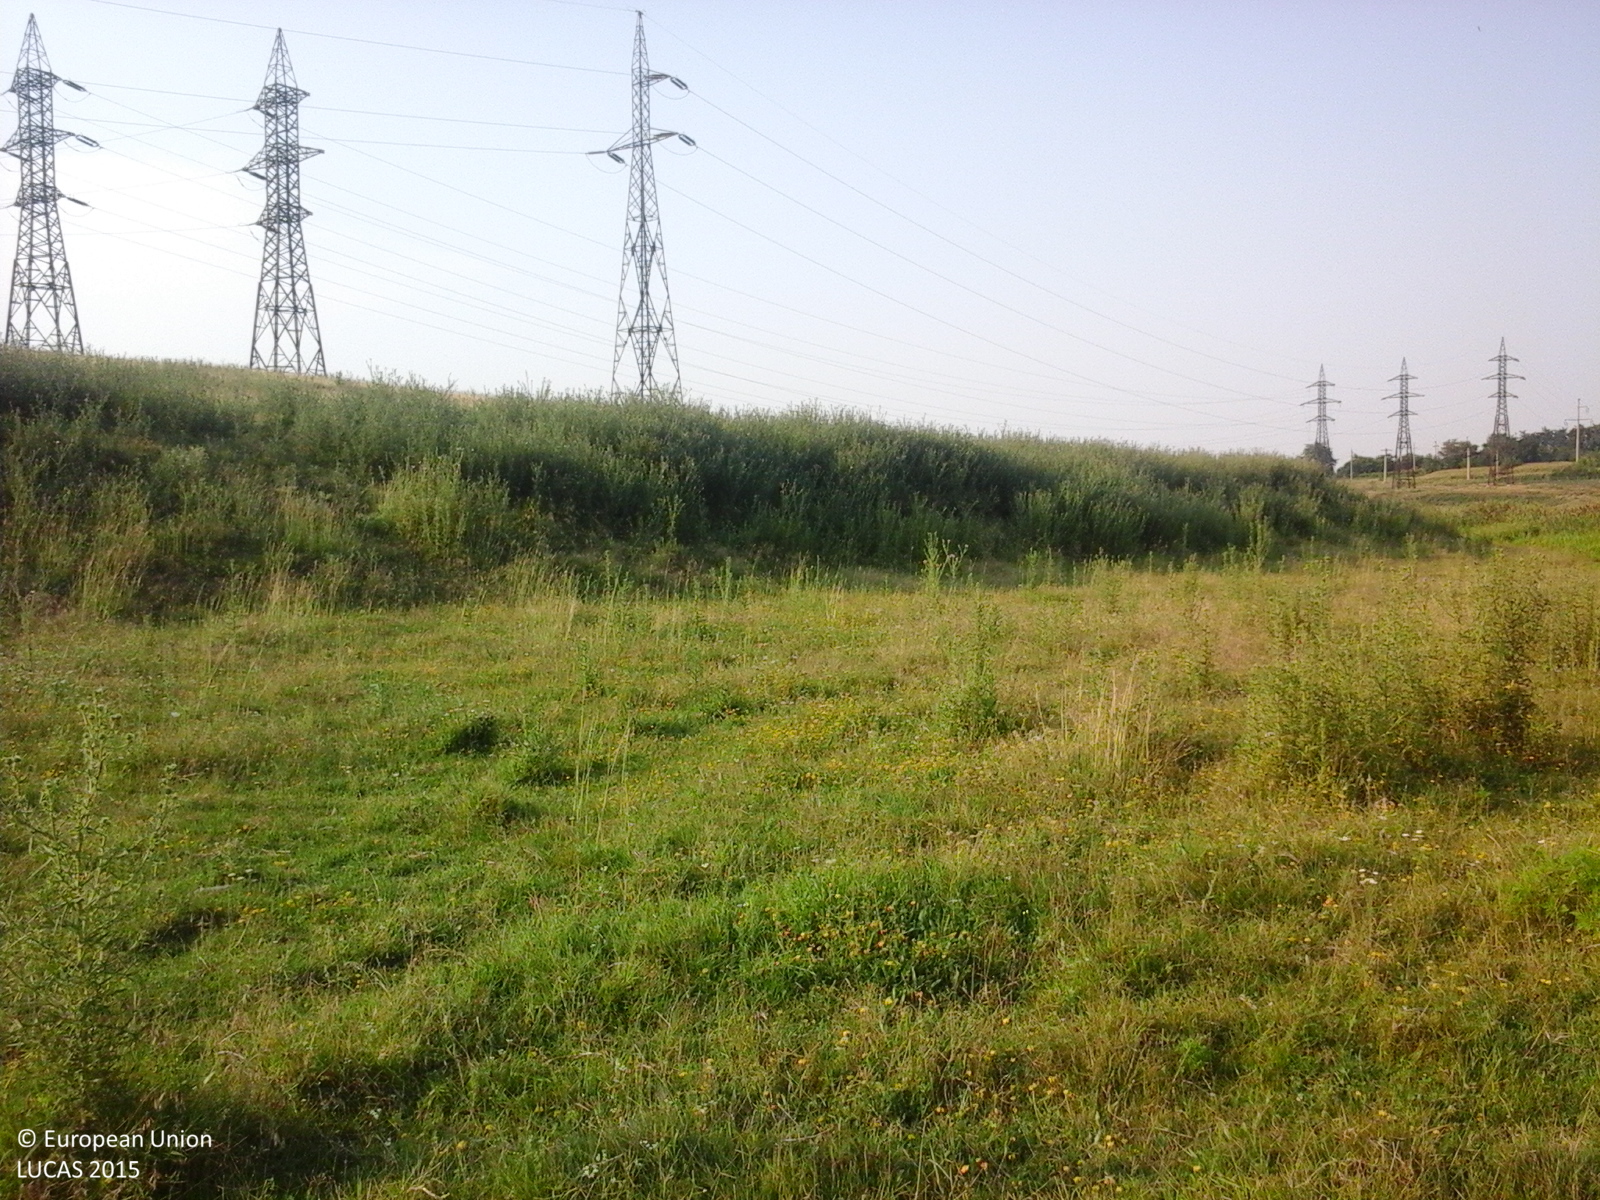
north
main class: Grassland
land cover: Spontaneously vegetated surfaces
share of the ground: > 75 %
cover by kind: herbaceous plants 100 %
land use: Fallow land
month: July
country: RO
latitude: 44.4594
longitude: 26.5689
